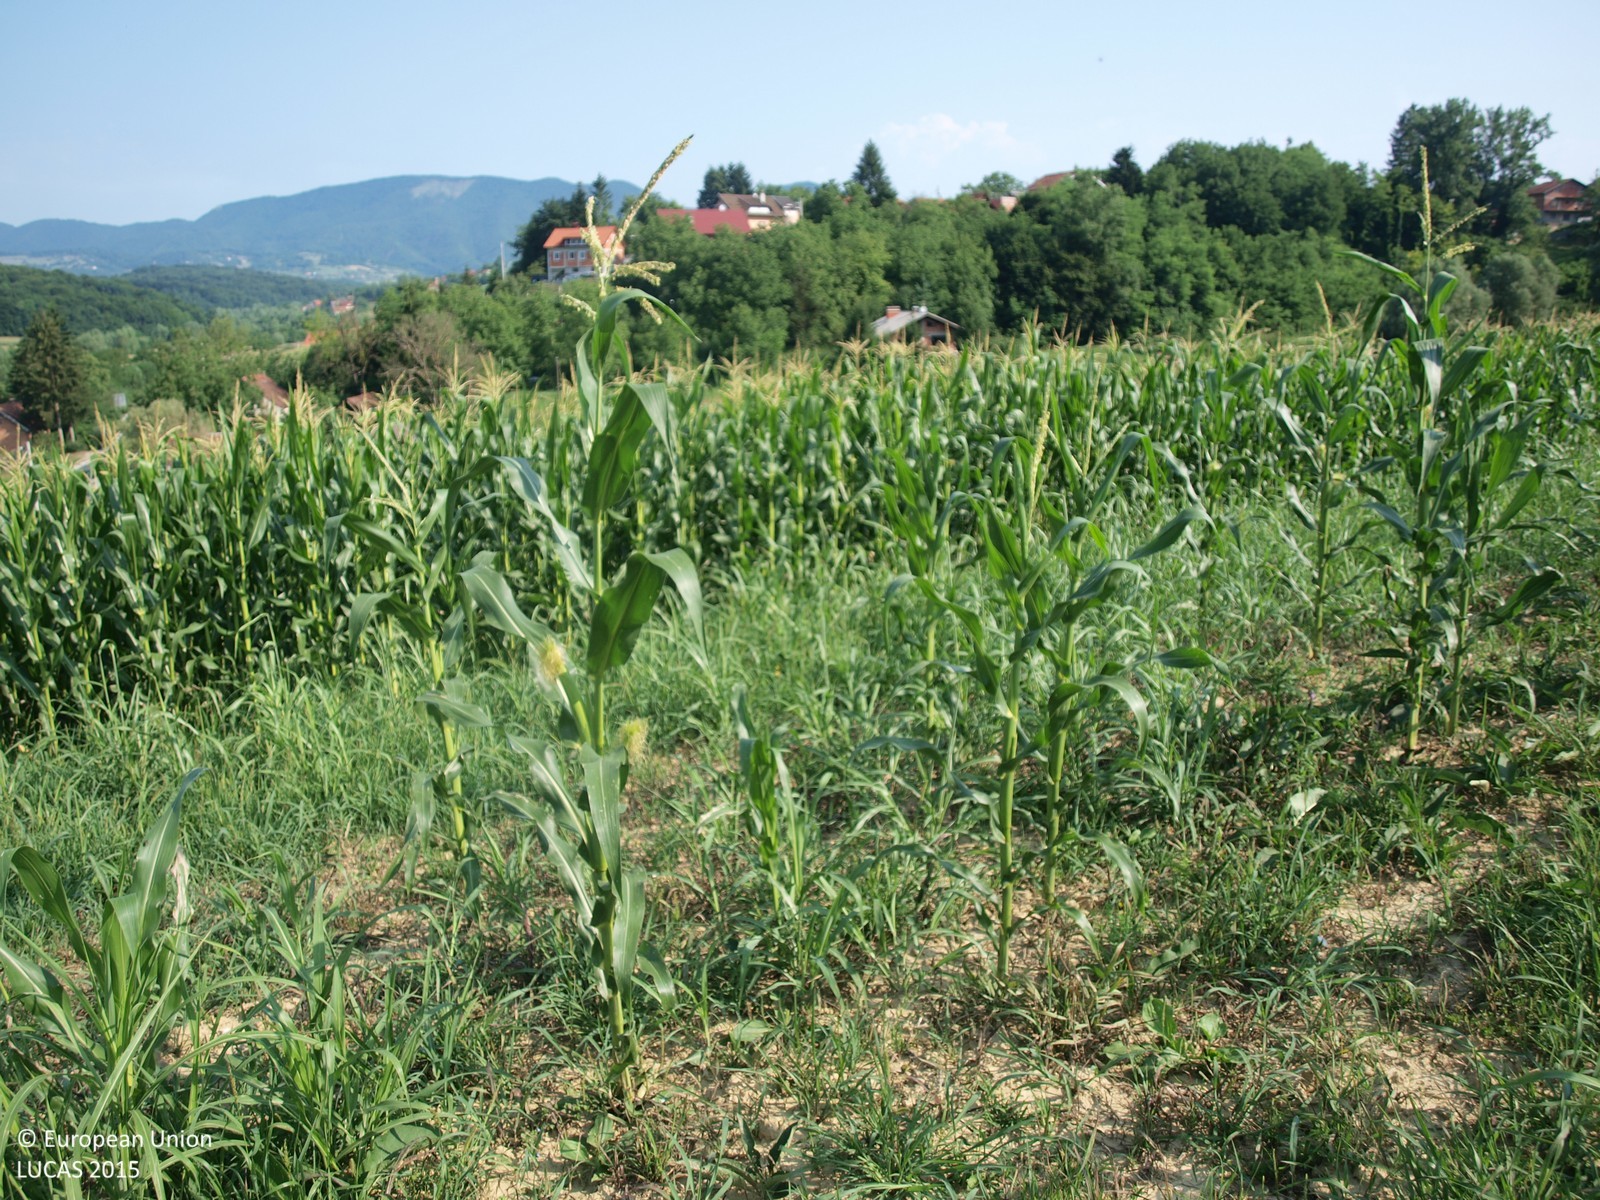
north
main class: Cropland
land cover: Maize
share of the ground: 10 - 25 %
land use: Agriculture (excluding fallow land and kitchen gardens)
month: July
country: HR
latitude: 46.1320
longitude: 15.9396
